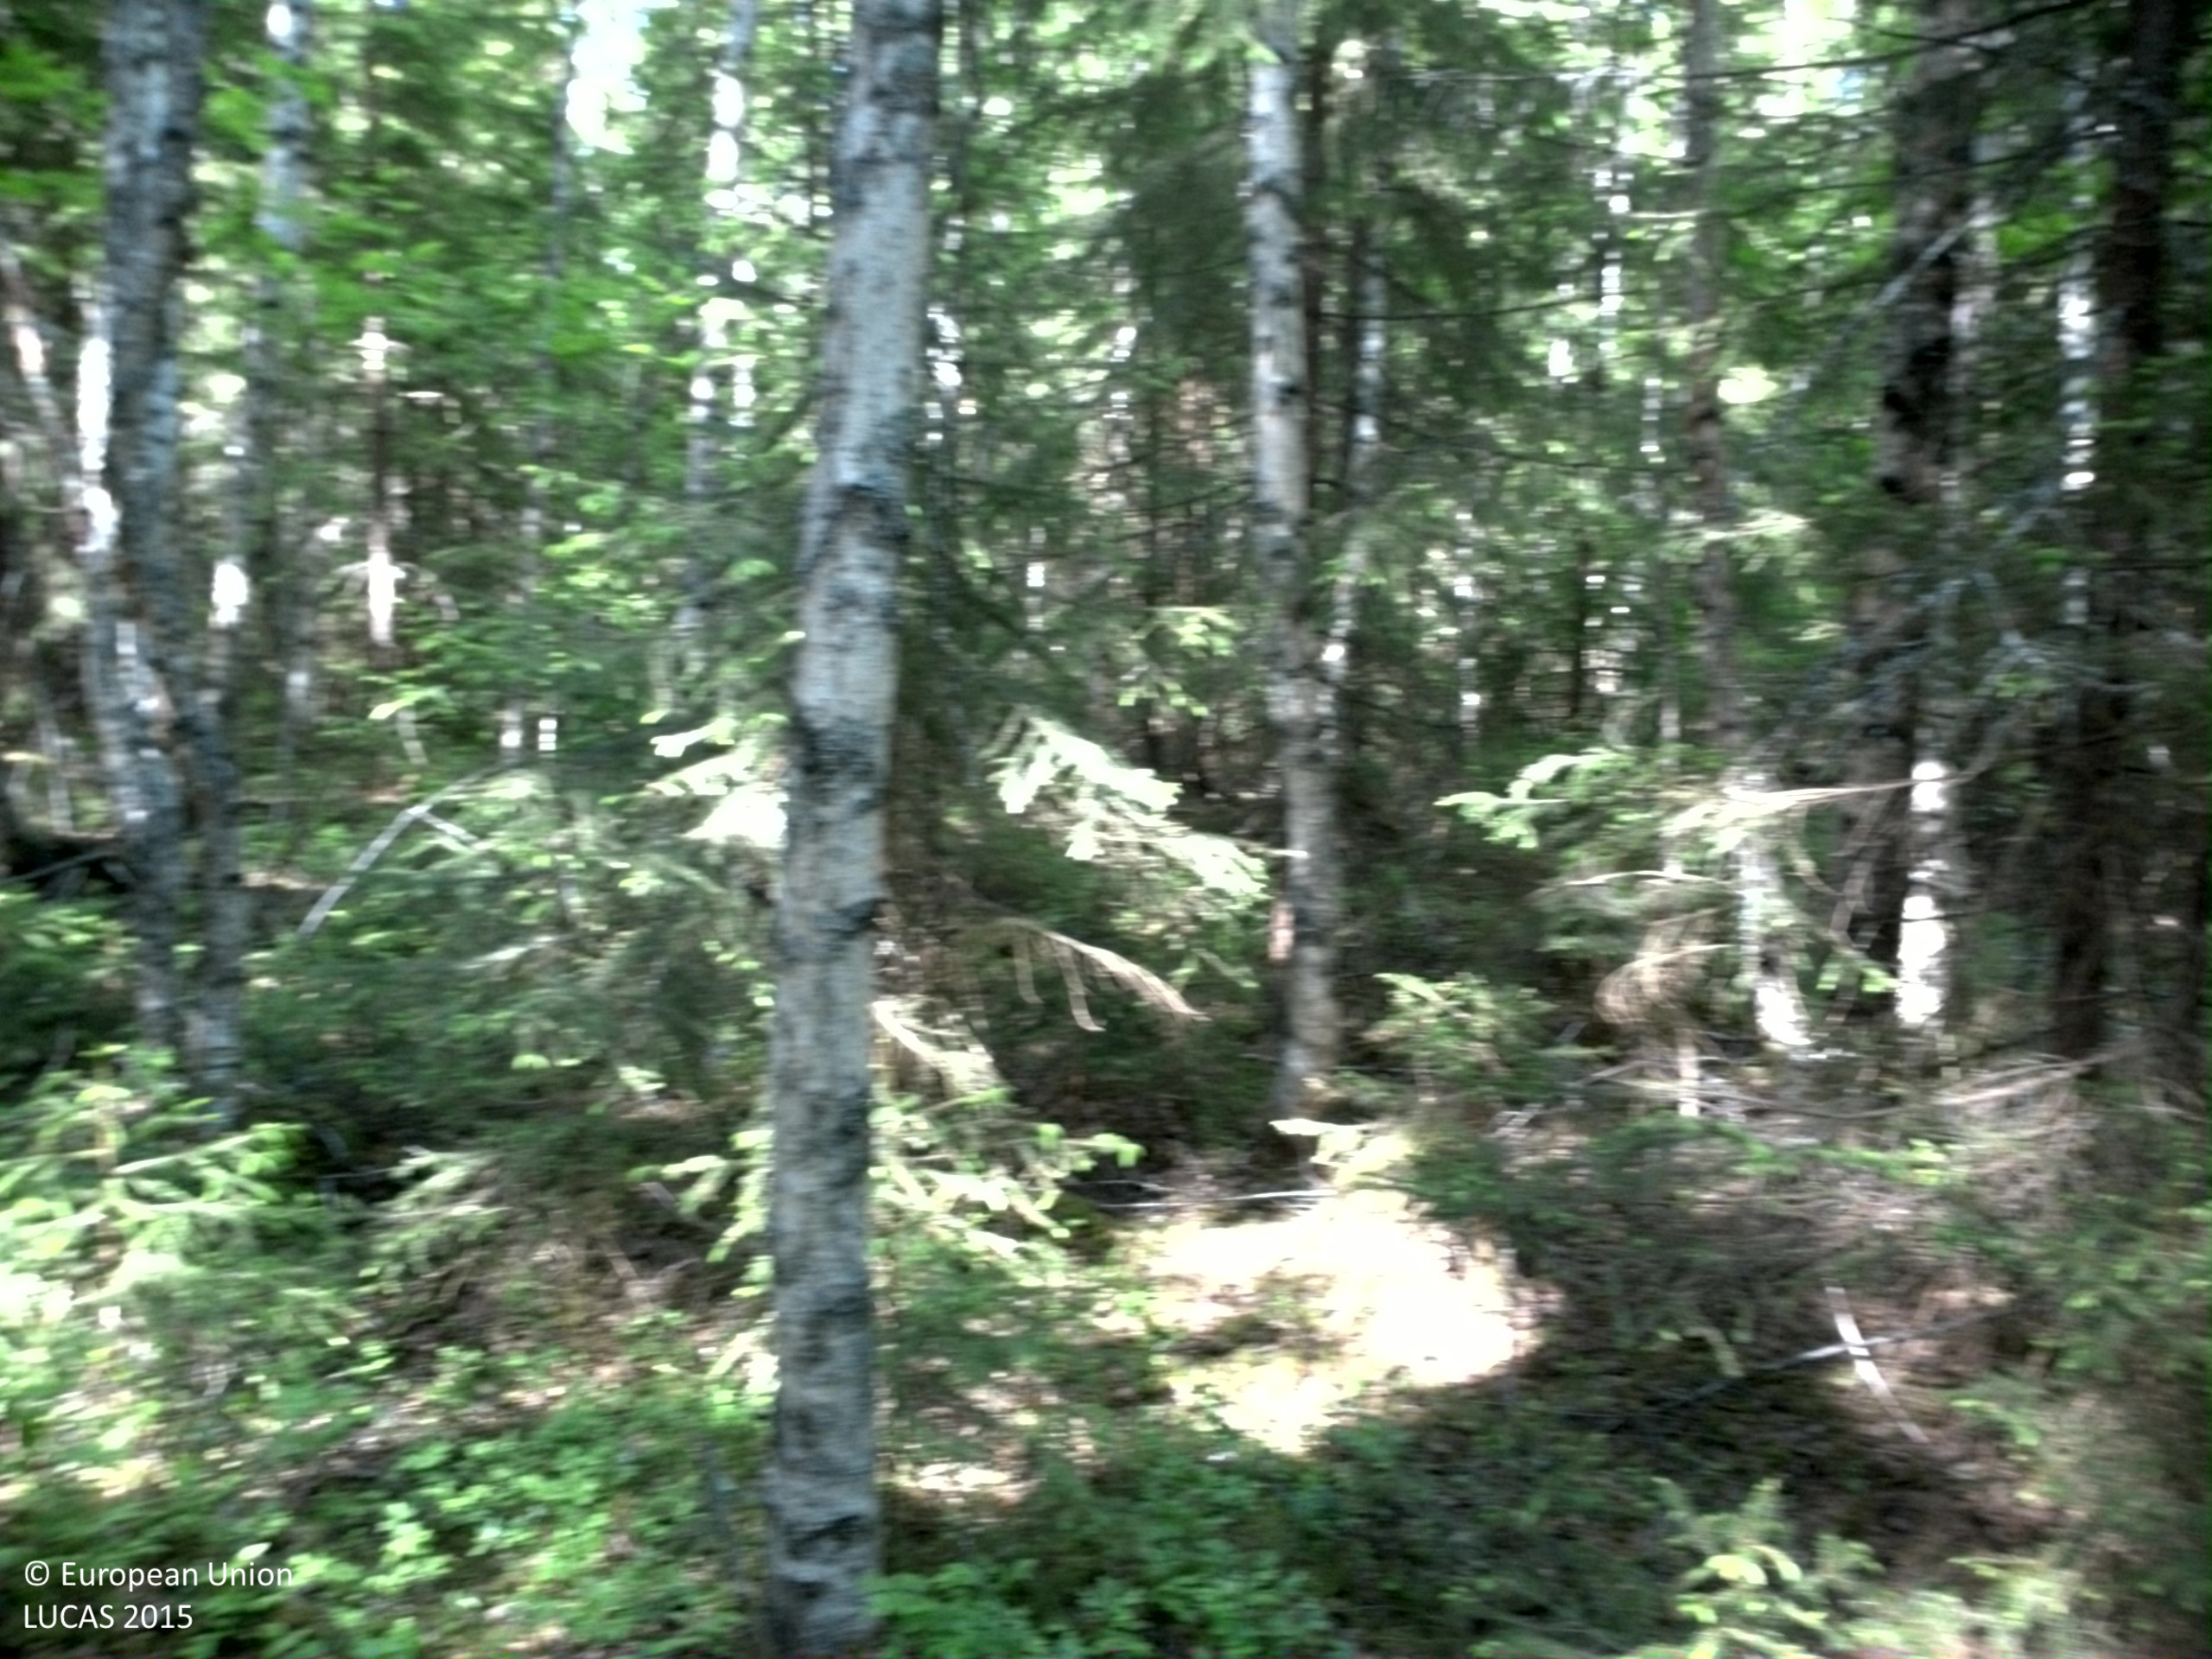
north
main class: Woodland
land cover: Broadleaved woodland
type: boreal forest
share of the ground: 50 - 75 %
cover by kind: broadleaved forest trees 60 %, herbaceous plants 20 %, shrubs 15 %, coniferous forest trees 5 %
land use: Forestry
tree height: > 5 m
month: June
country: SE
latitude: 63.1388
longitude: 17.7333
